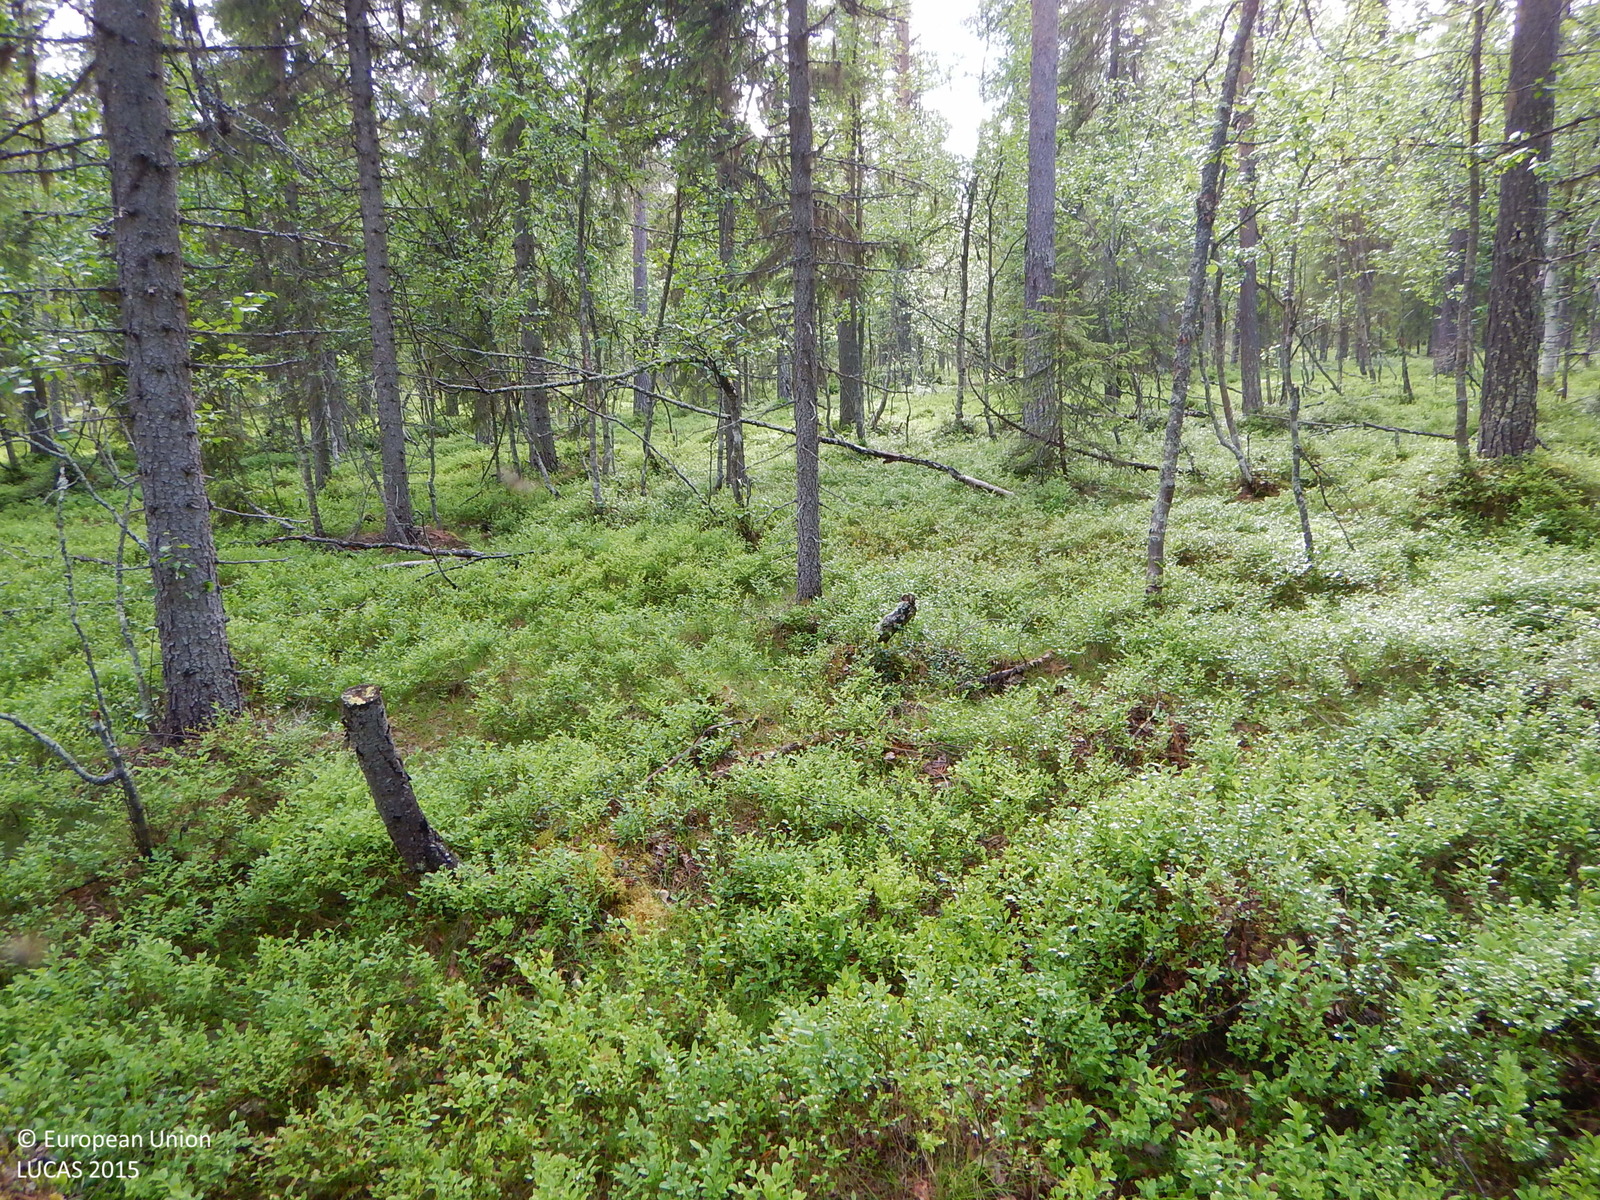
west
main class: Woodland
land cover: Other mixed woodland
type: boreal forest
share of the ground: 50 - 75 %
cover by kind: coniferous forest trees 45 %, shrubs 20 %, broadleaved forest trees 15 %, herbaceous plants 15 %, lichens and mosses 5 %
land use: Forestry
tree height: > 5 m
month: July
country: SE
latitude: 65.2935
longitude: 19.2479
